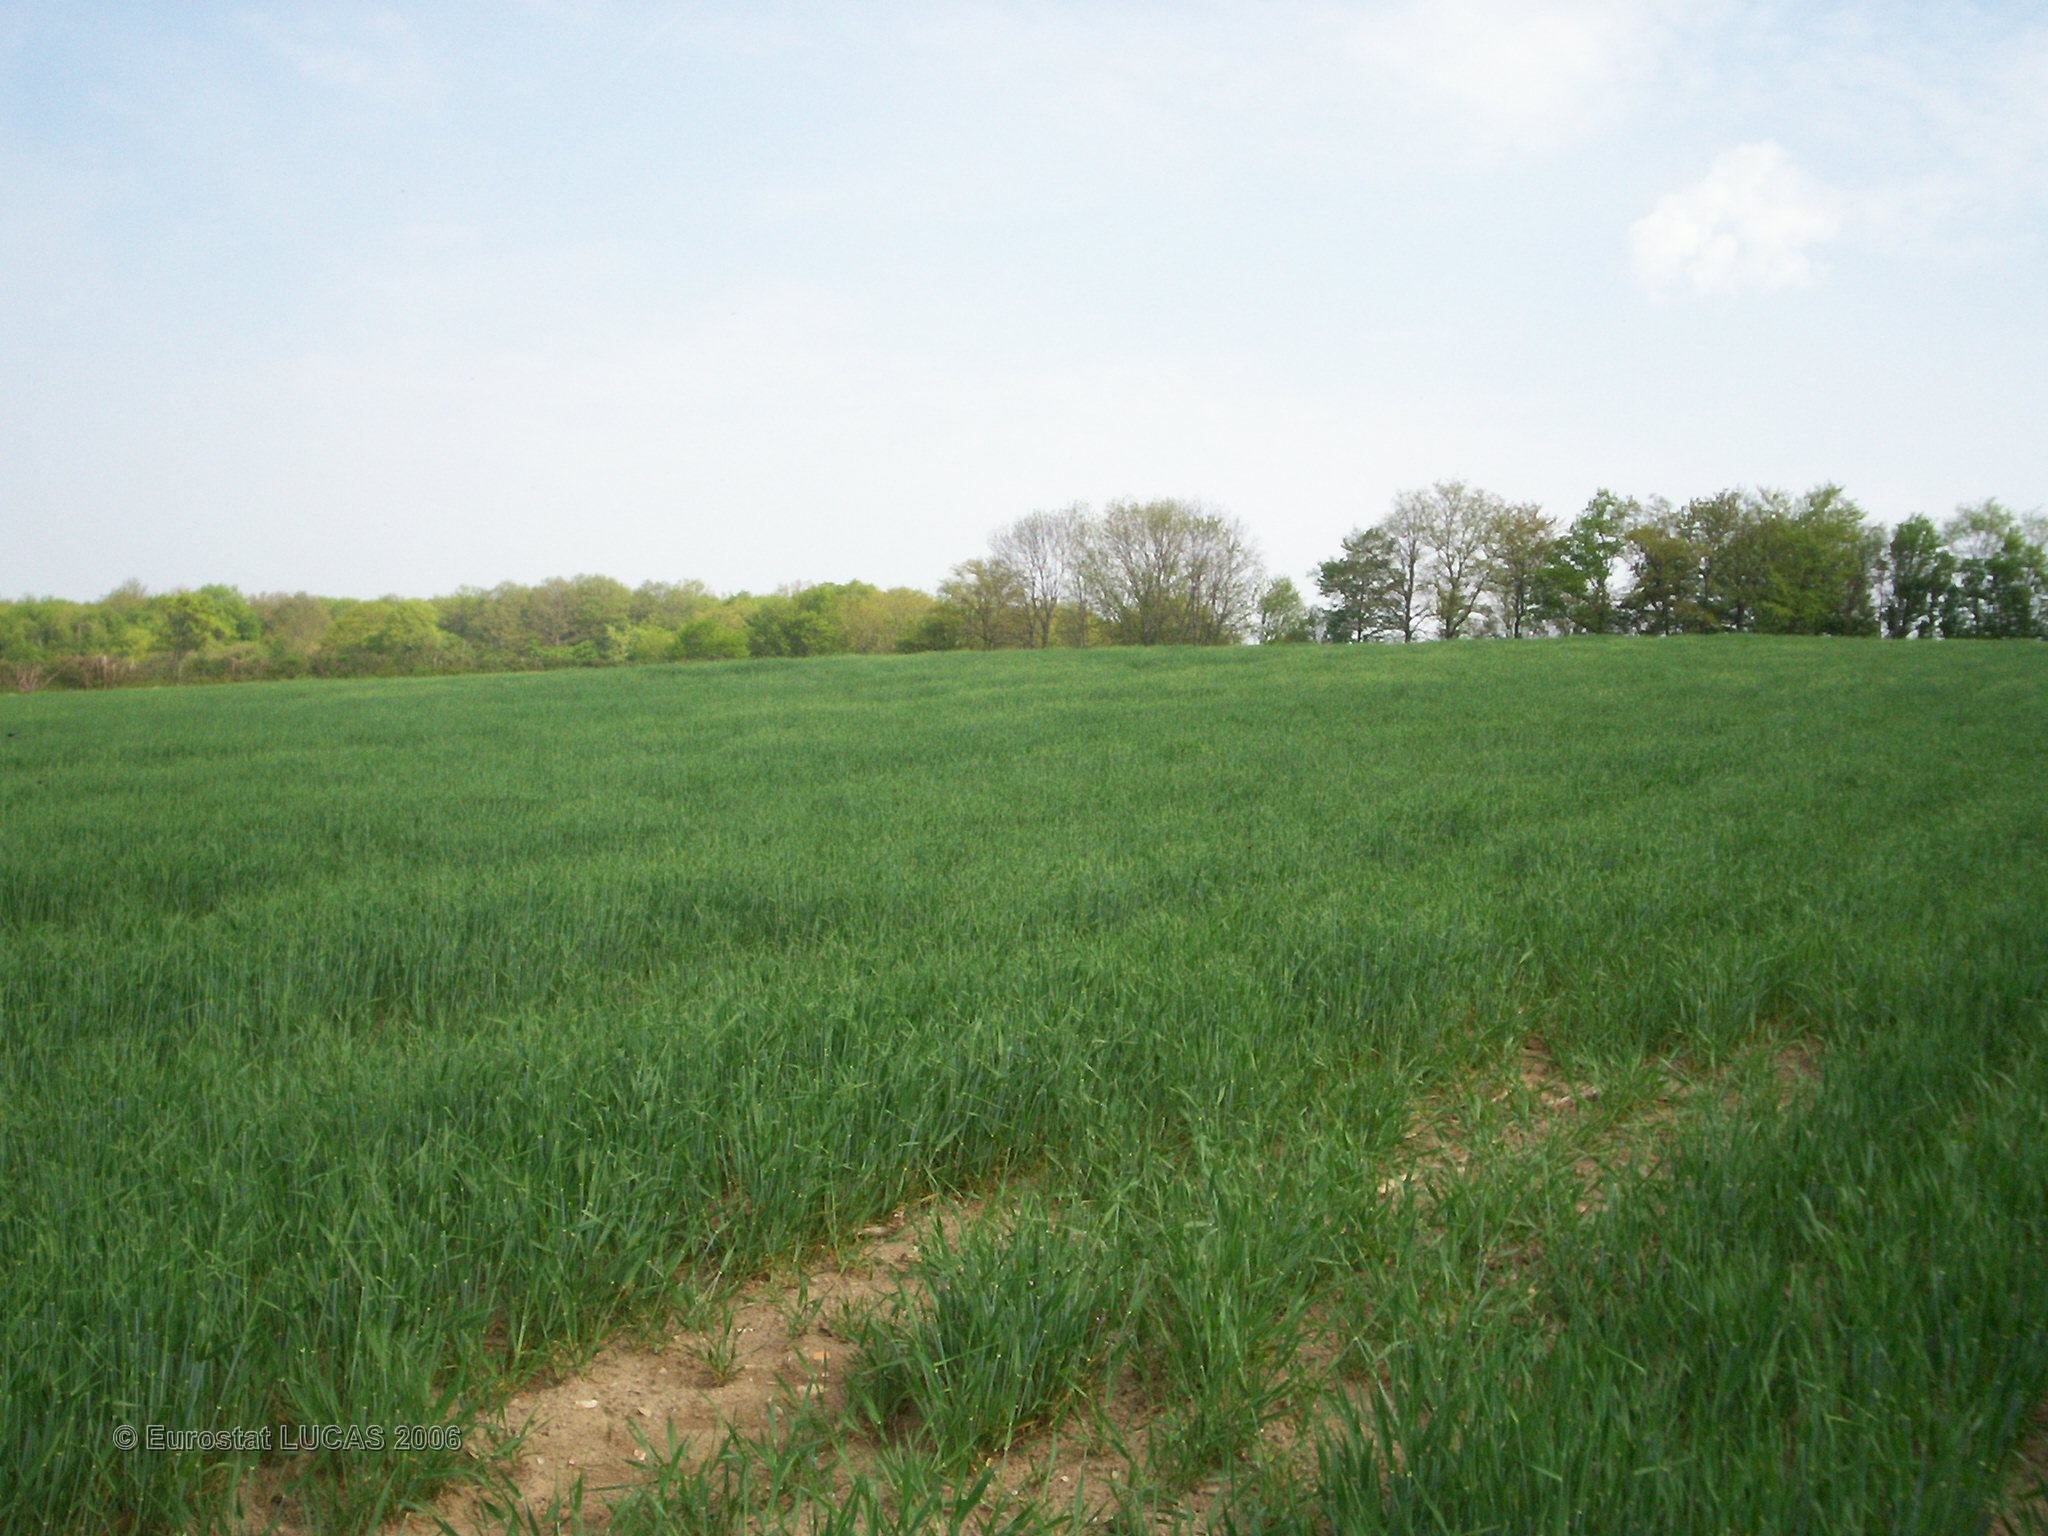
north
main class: Cropland
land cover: Barley
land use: Agriculture (excluding fallow land and kitchen gardens)
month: May
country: FR
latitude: 47.4295
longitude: 4.0189
